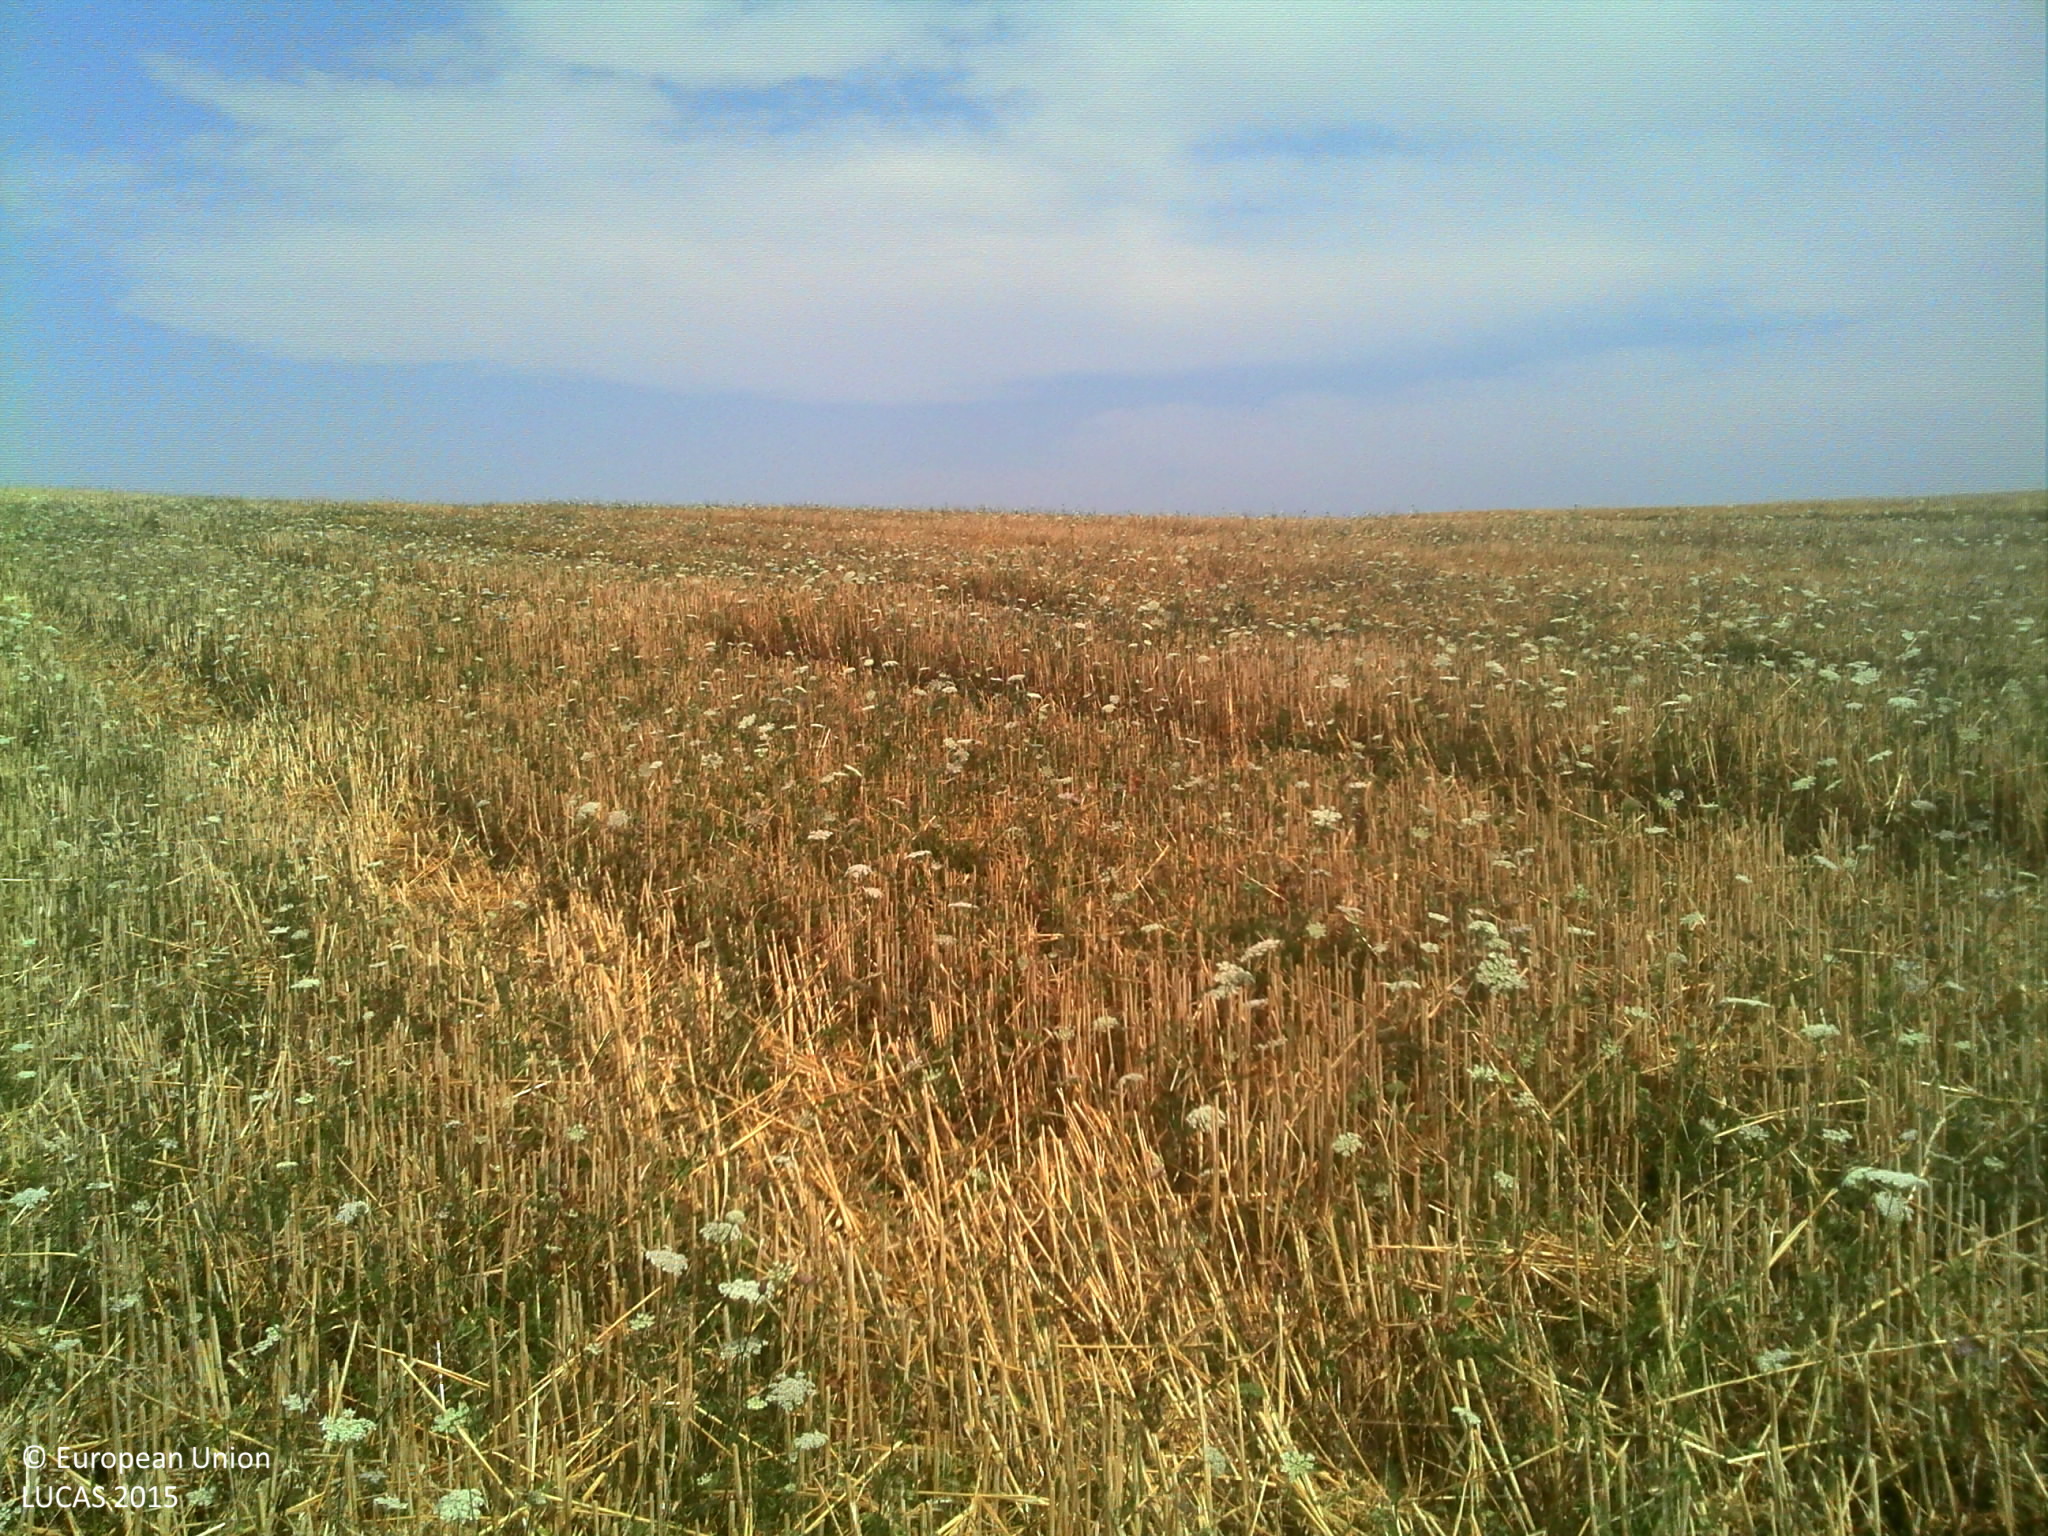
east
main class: Cropland
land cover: Barley
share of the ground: > 75 %
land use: Agriculture (excluding fallow land and kitchen gardens)
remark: Harvested field
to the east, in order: Barley; Grass margins; Ditches and canals; Grass margins; Paved roads, cycling and walking lanes; Grass margins; Ditches and canals; Grass margins; Common wheat; Grass margins; Ditches and canals; Grass margins; Paved roads, cycling and walking lanes; Grass margins; Ditches and canals; Grass margins; Rape and turnip rape
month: July
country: FR
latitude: 43.2912
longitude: 1.0421
